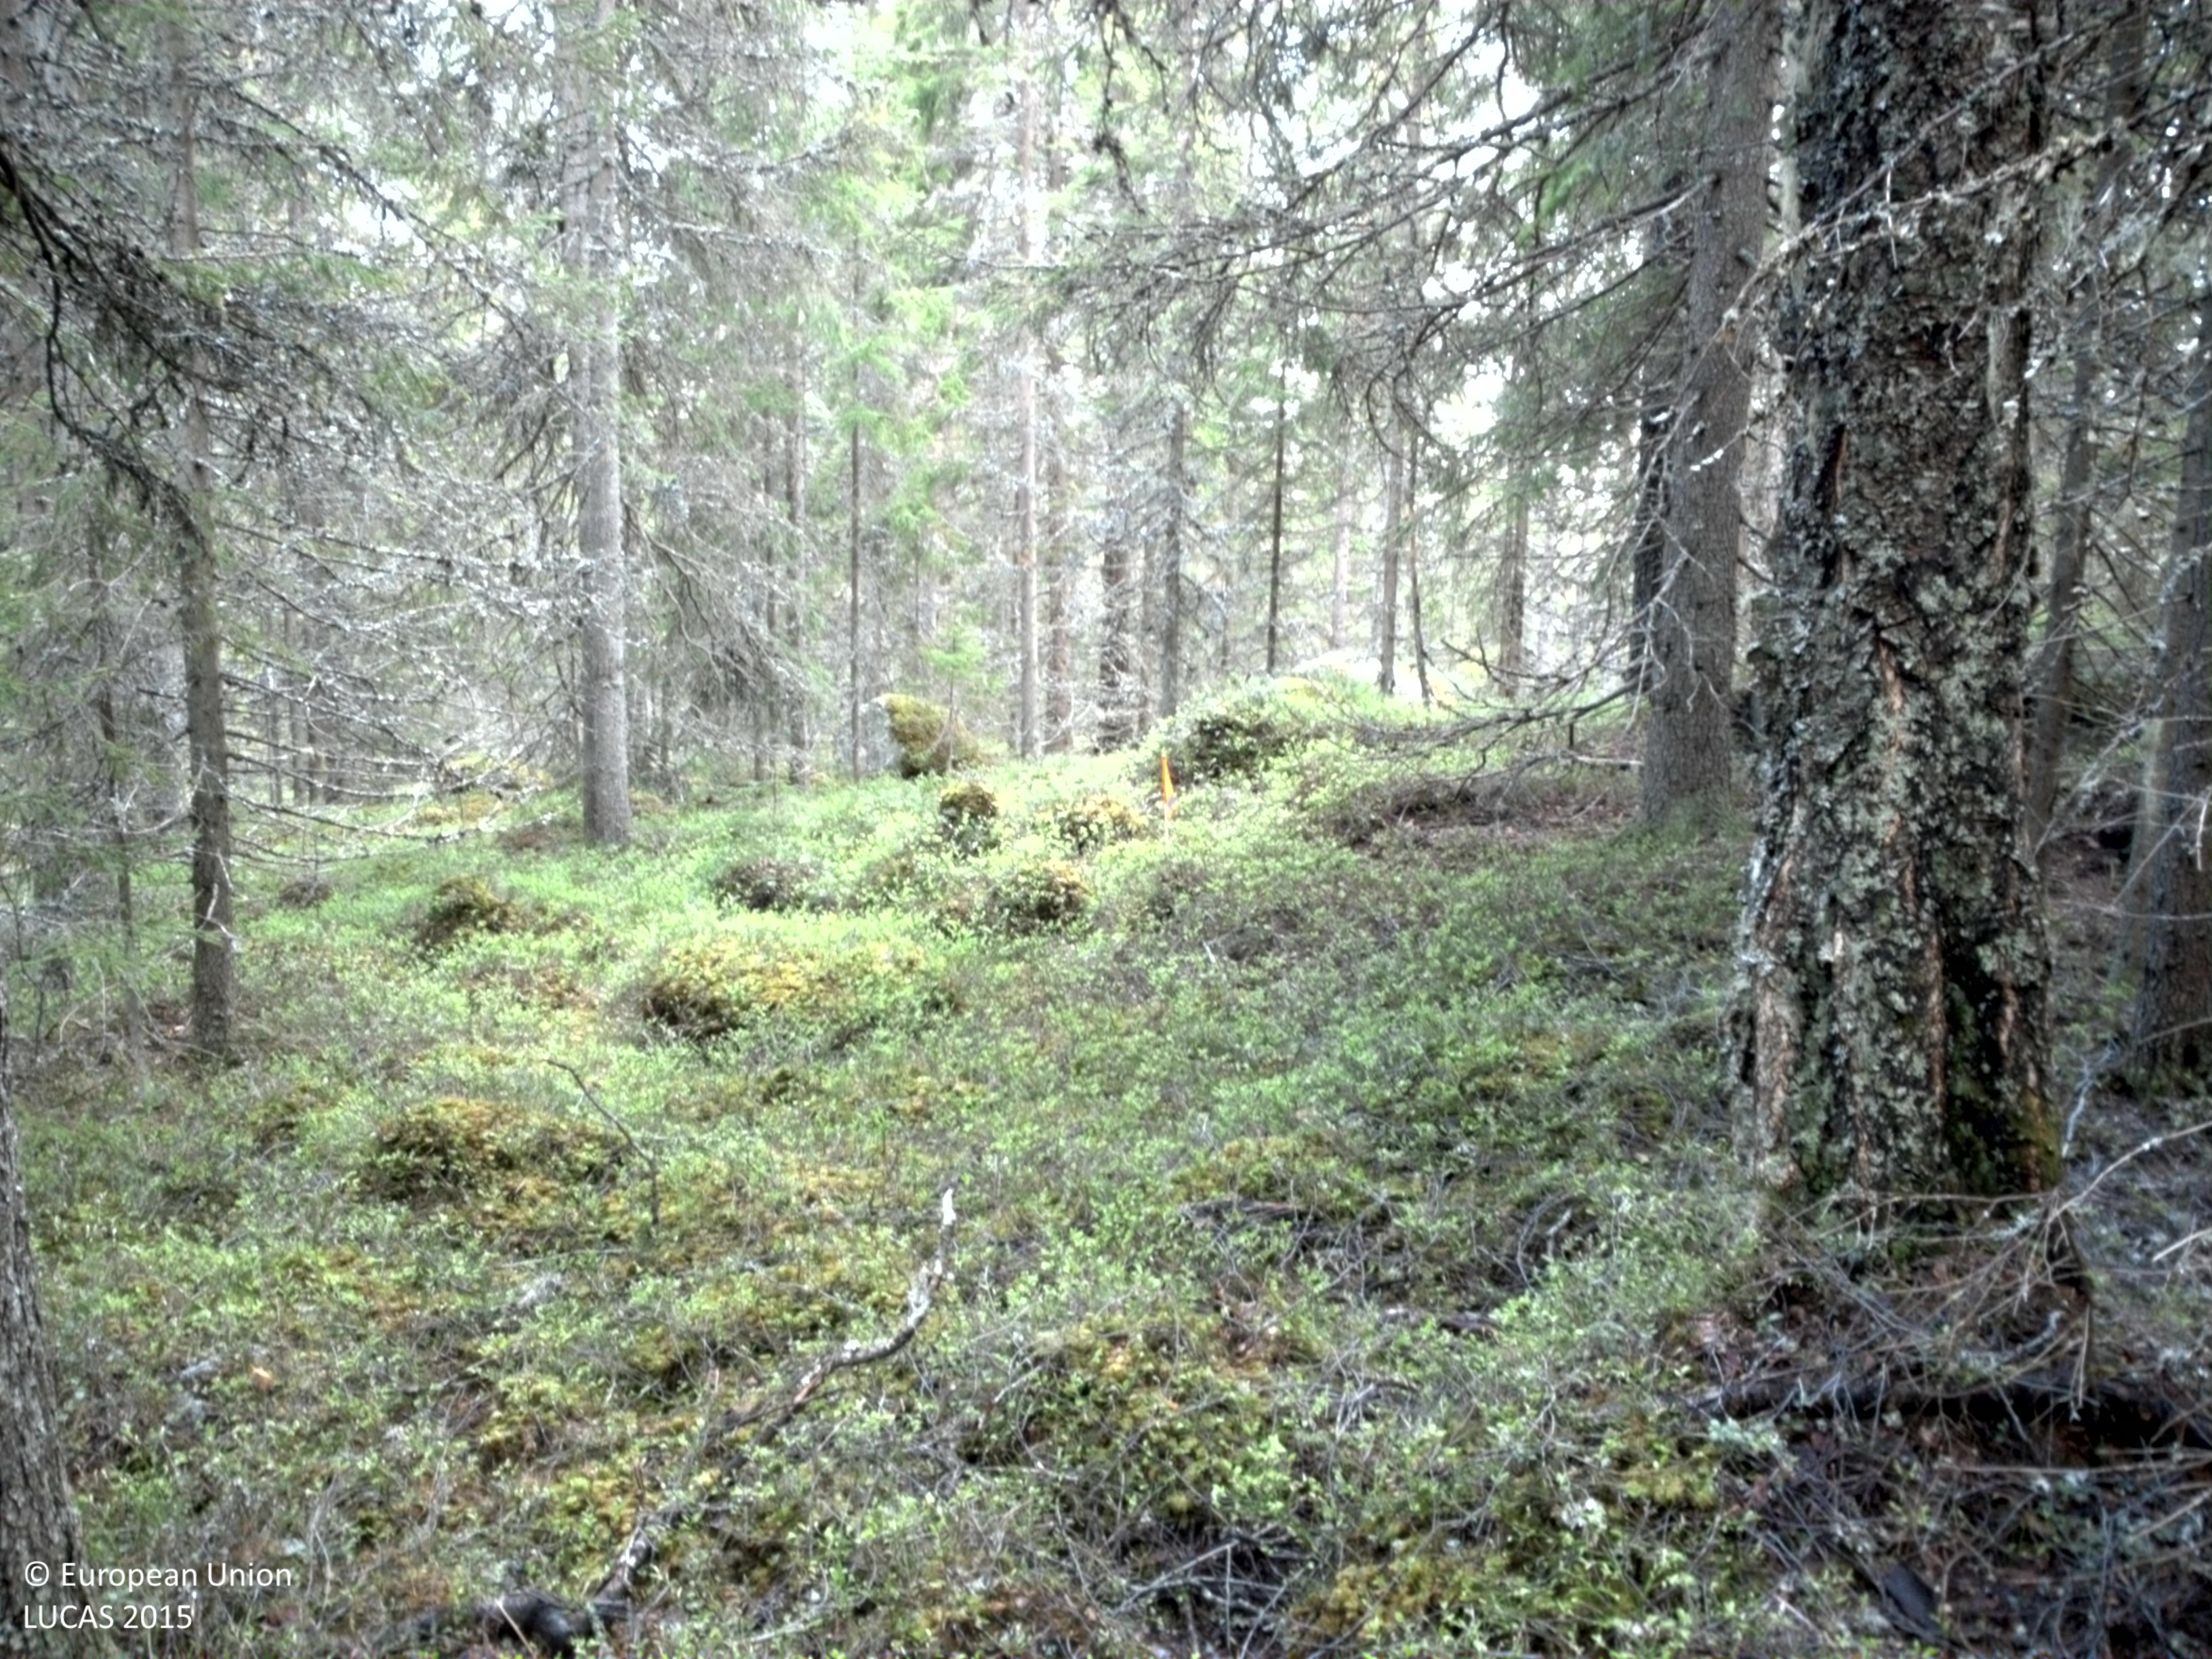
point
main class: Woodland
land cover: Spruce dominated coniferous woodland
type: boreal forest
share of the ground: 50 - 75 %
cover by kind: coniferous forest trees 70 %, shrubs 30 %
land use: Forestry
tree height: > 5 m
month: June
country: SE
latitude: 60.6115
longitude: 13.2600
